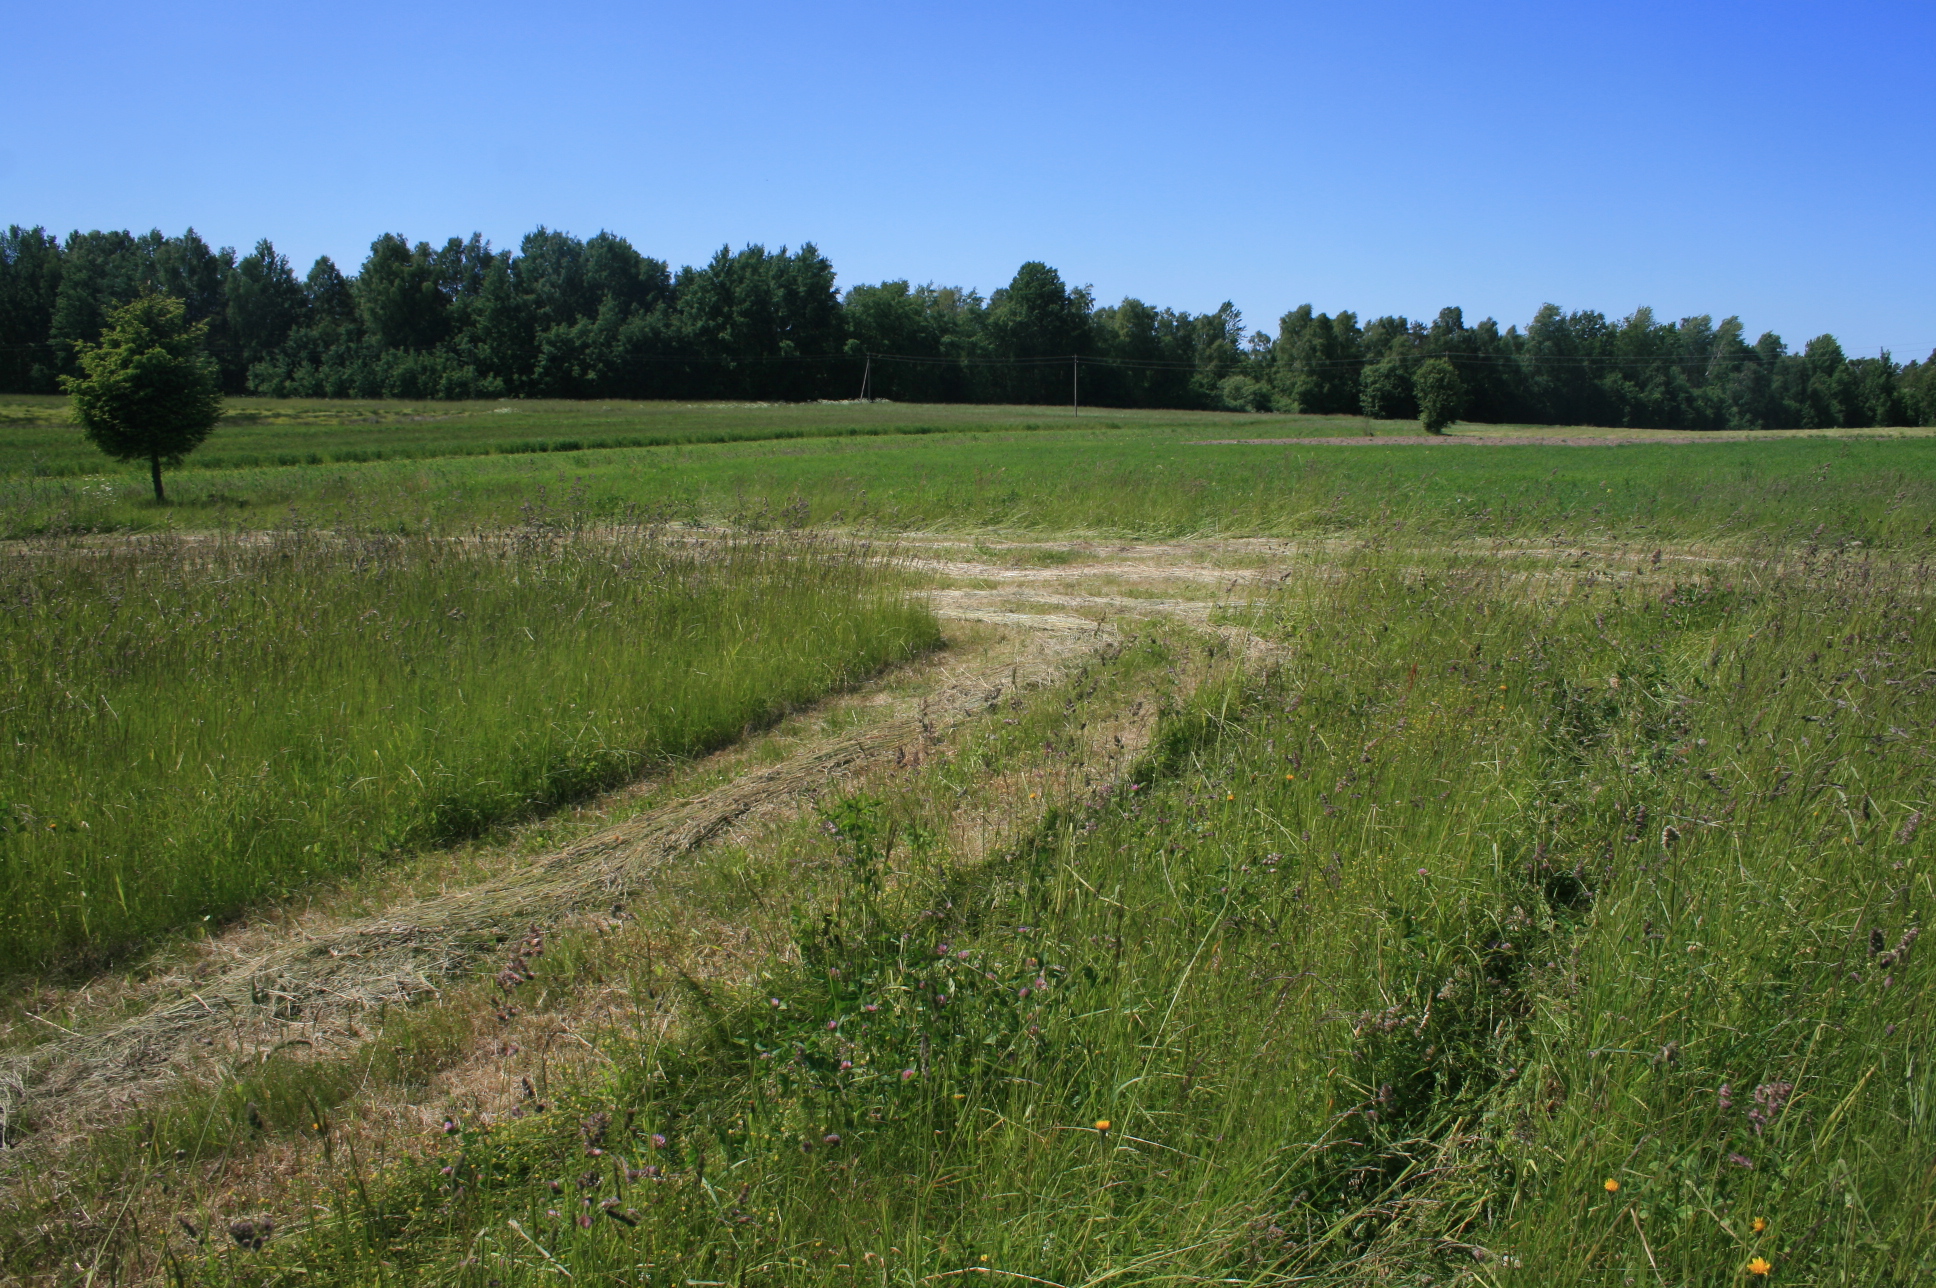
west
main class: Grassland
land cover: Grassland without tree/shrub cover
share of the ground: > 75 %
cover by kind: herbaceous plants 100 %
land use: Agriculture (excluding fallow land and kitchen gardens)
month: June
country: LT
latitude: 55.5148
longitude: 22.1707
